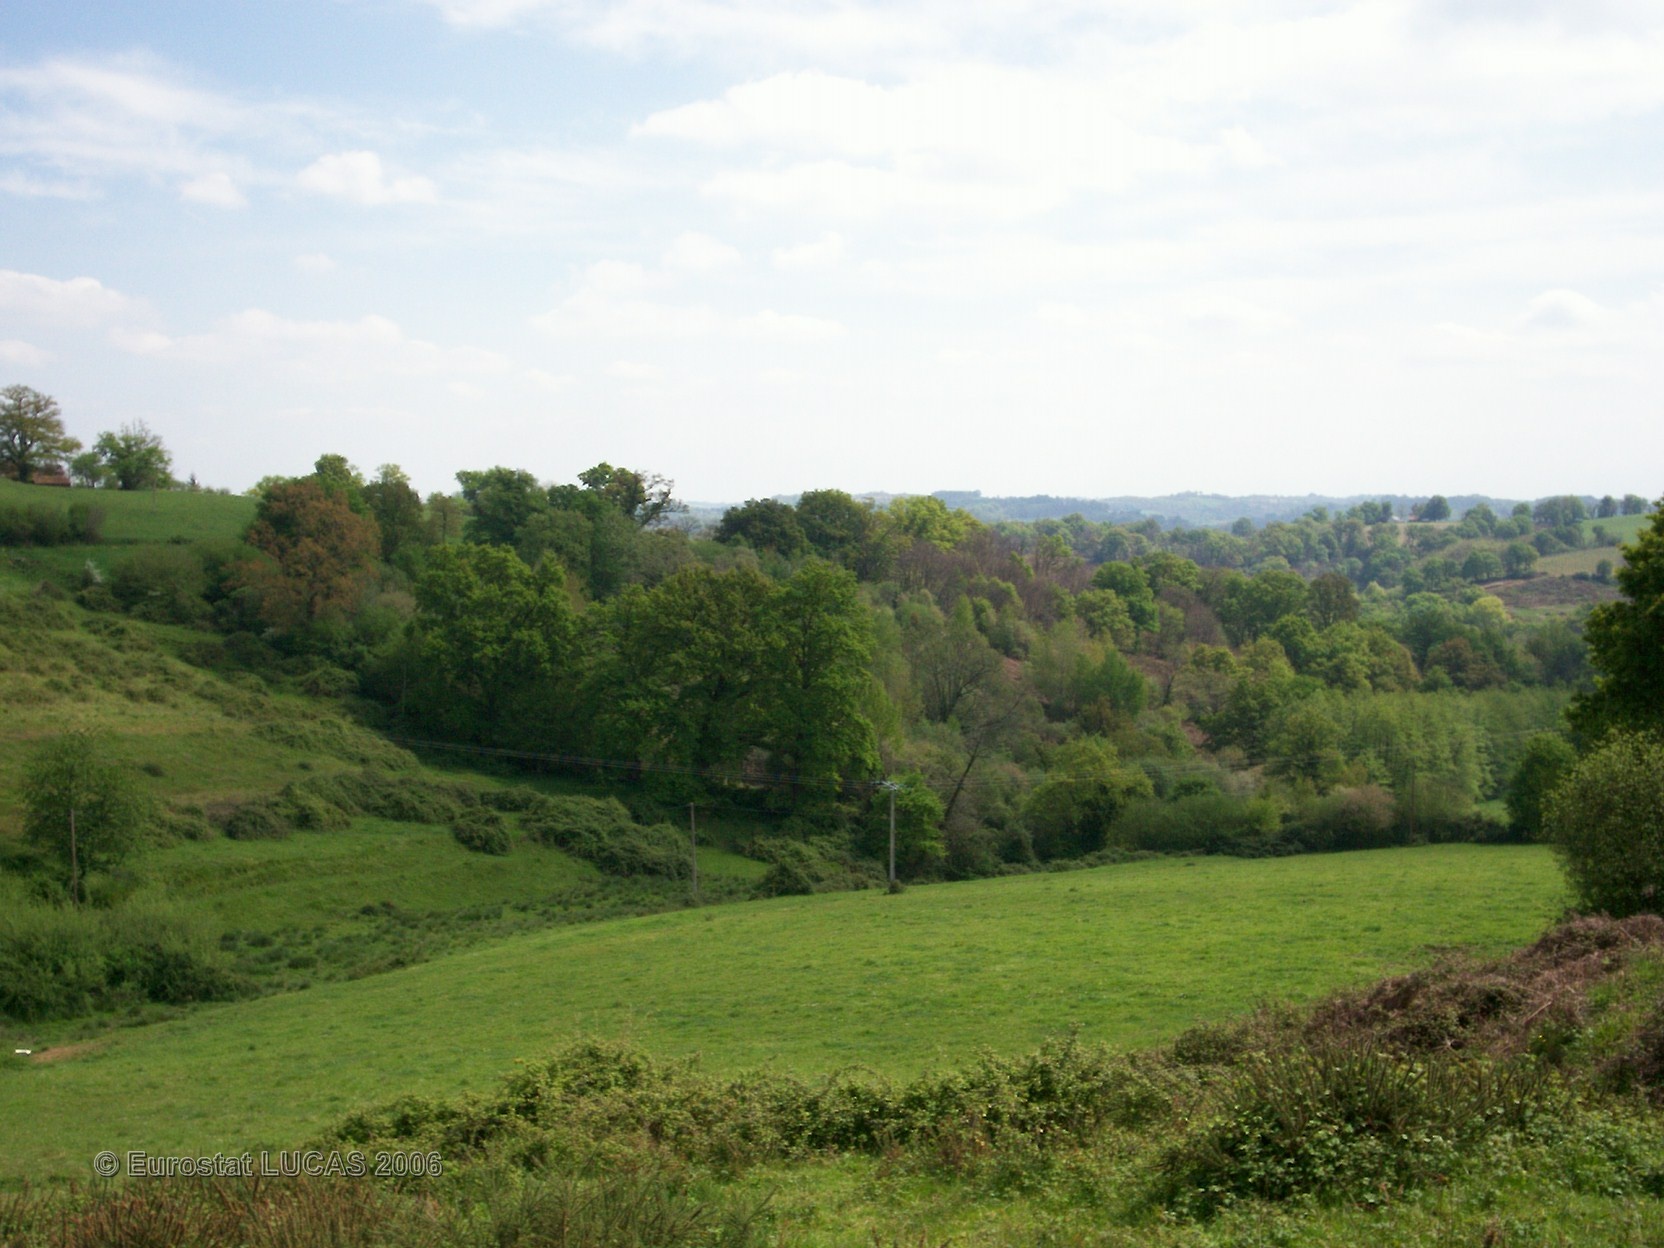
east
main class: Grassland
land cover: Grassland without tree/shrub cover
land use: Agriculture (excluding fallow land and kitchen gardens)
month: April
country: FR
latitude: 43.3305
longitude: -0.6278
